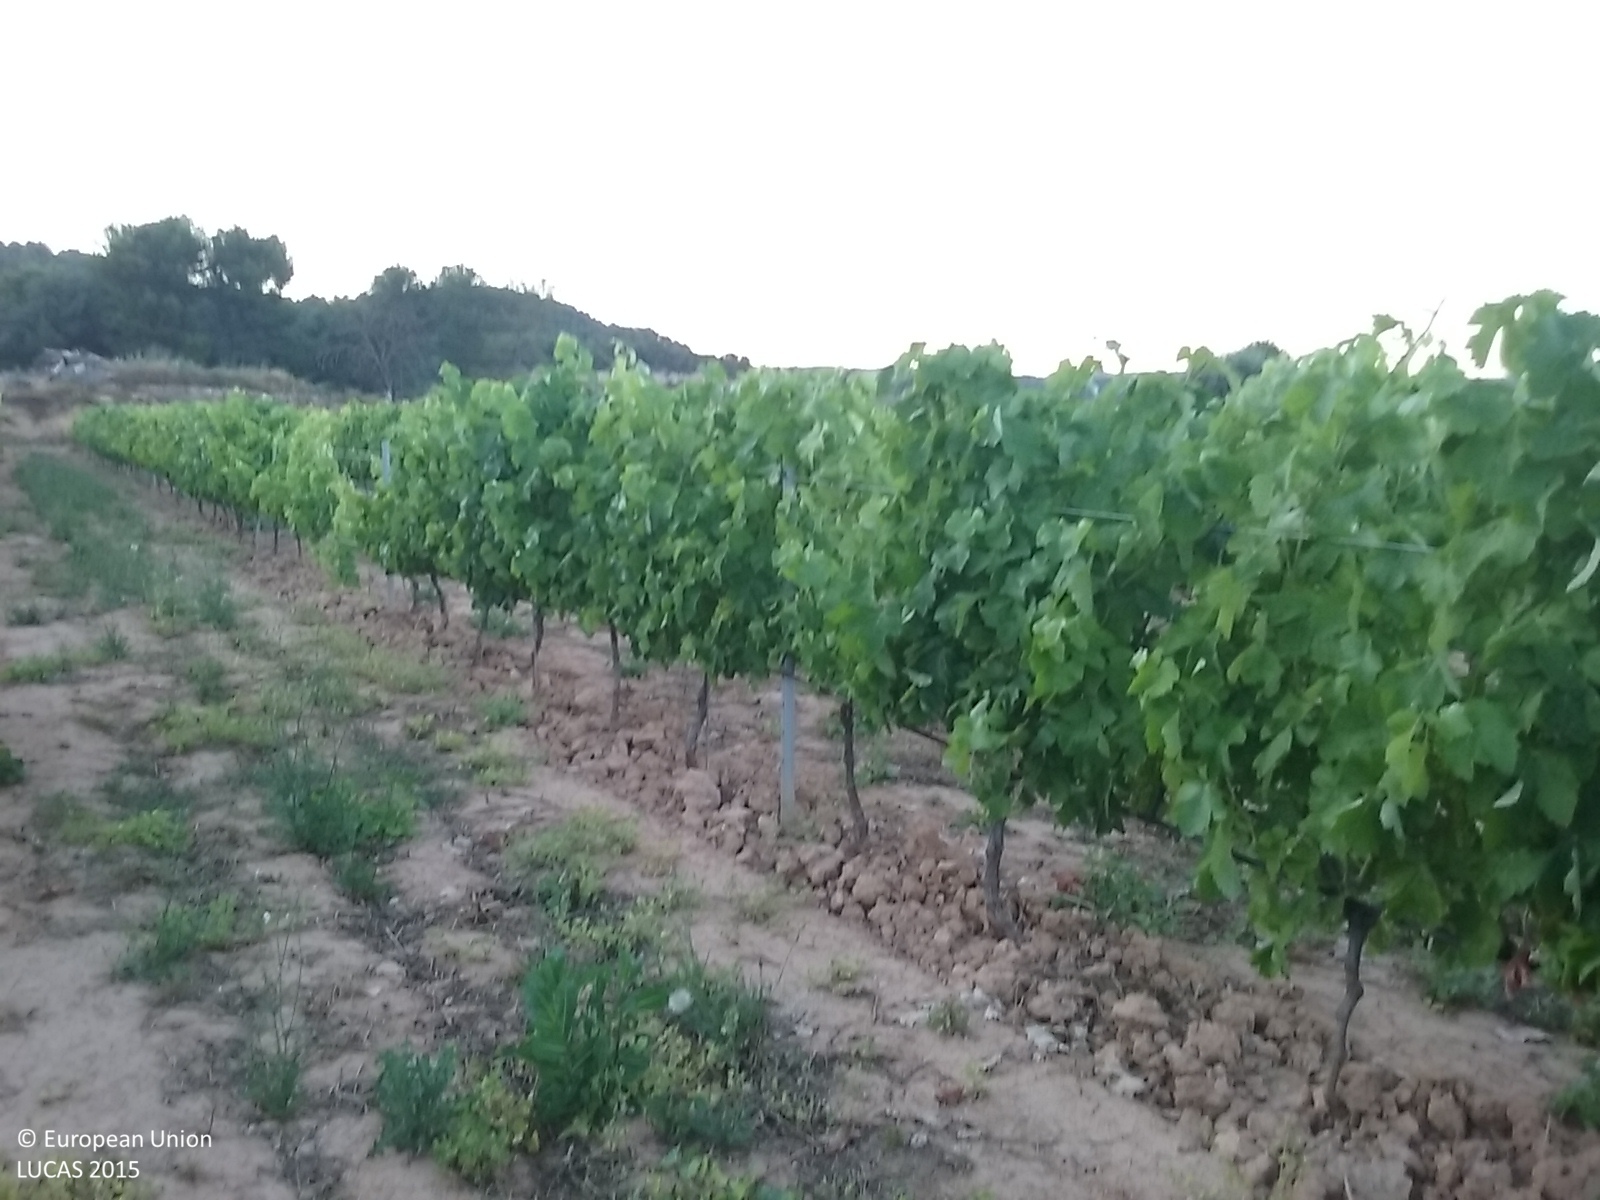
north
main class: Cropland
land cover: Vineyards
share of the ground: 10 - 25 %
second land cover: Spontaneously vegetated surfaces
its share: 10 - 25 %
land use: Agriculture (excluding fallow land and kitchen gardens)
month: June
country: ES
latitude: 41.0100
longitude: 0.3484
